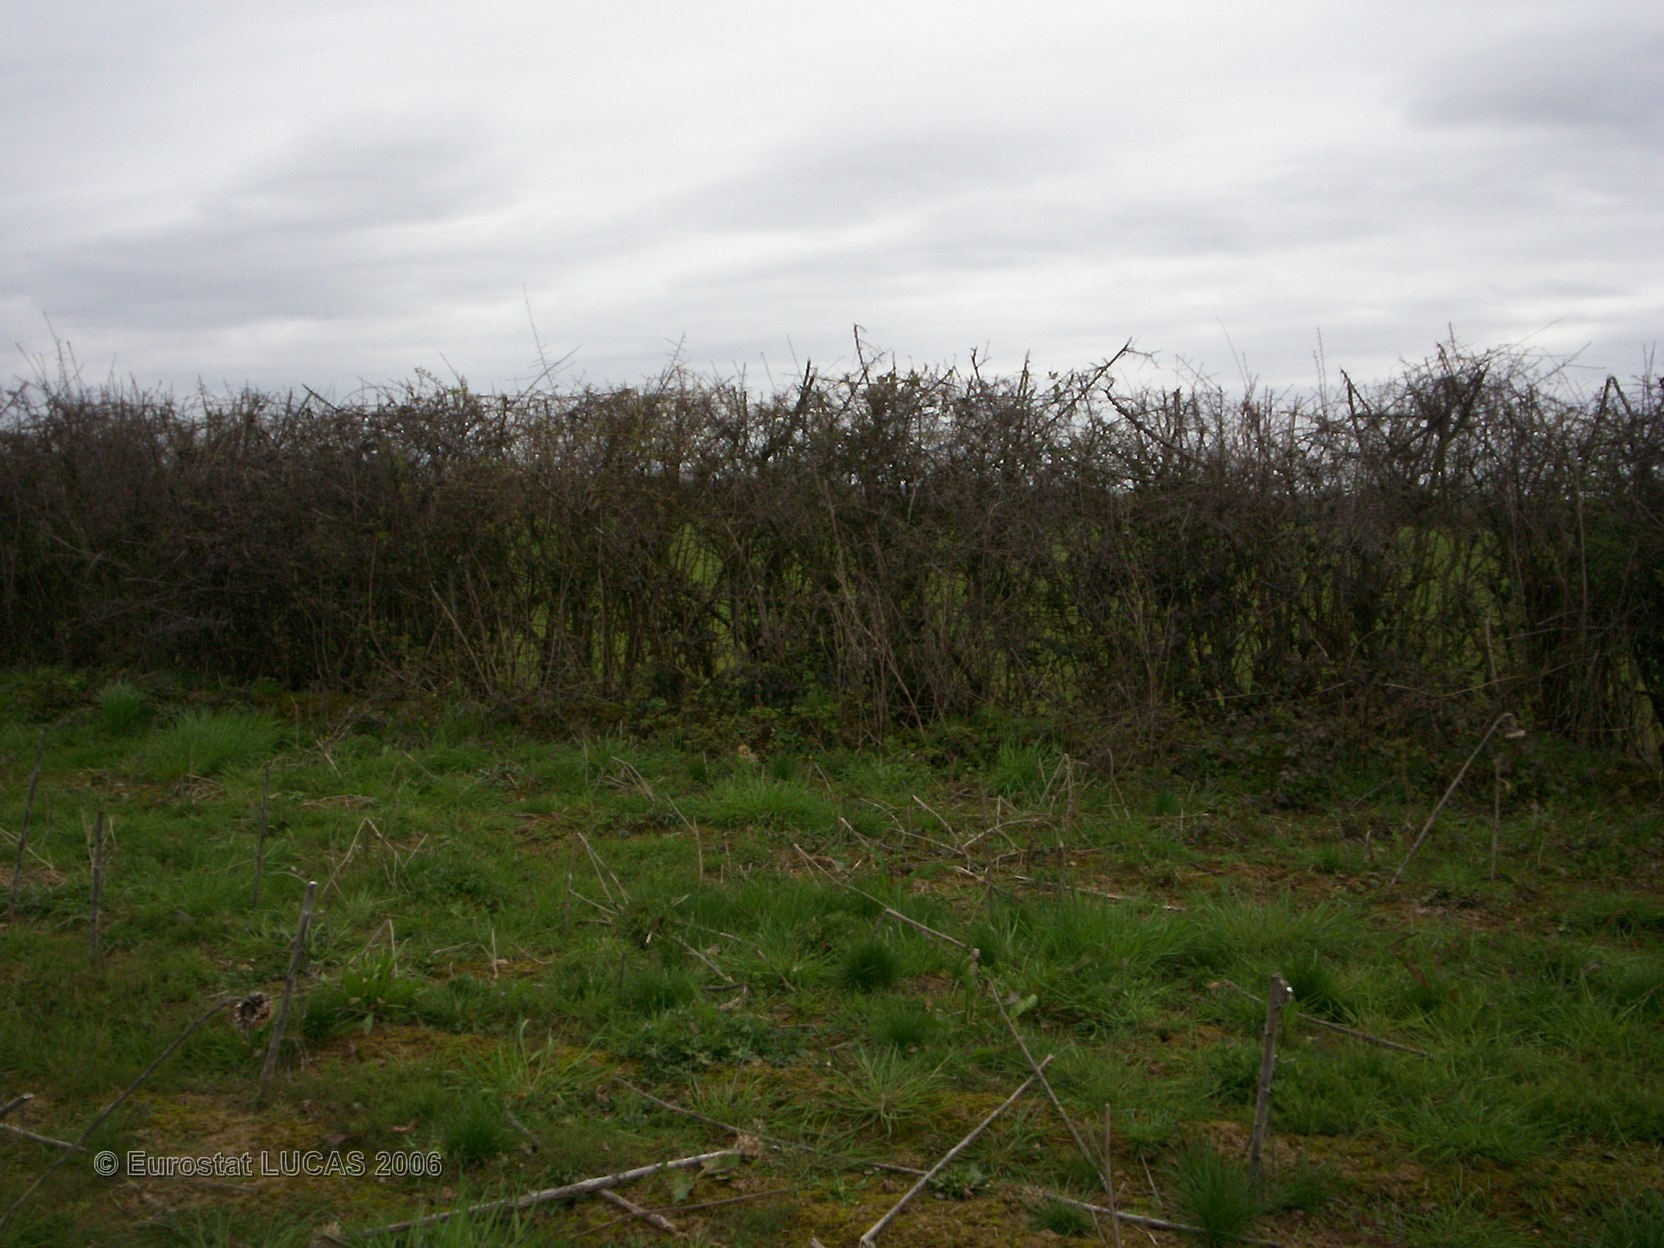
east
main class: Grassland
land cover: Grassland without tree/shrub cover
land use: Fallow land
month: April
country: FR
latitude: 46.7052
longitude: 3.0778
